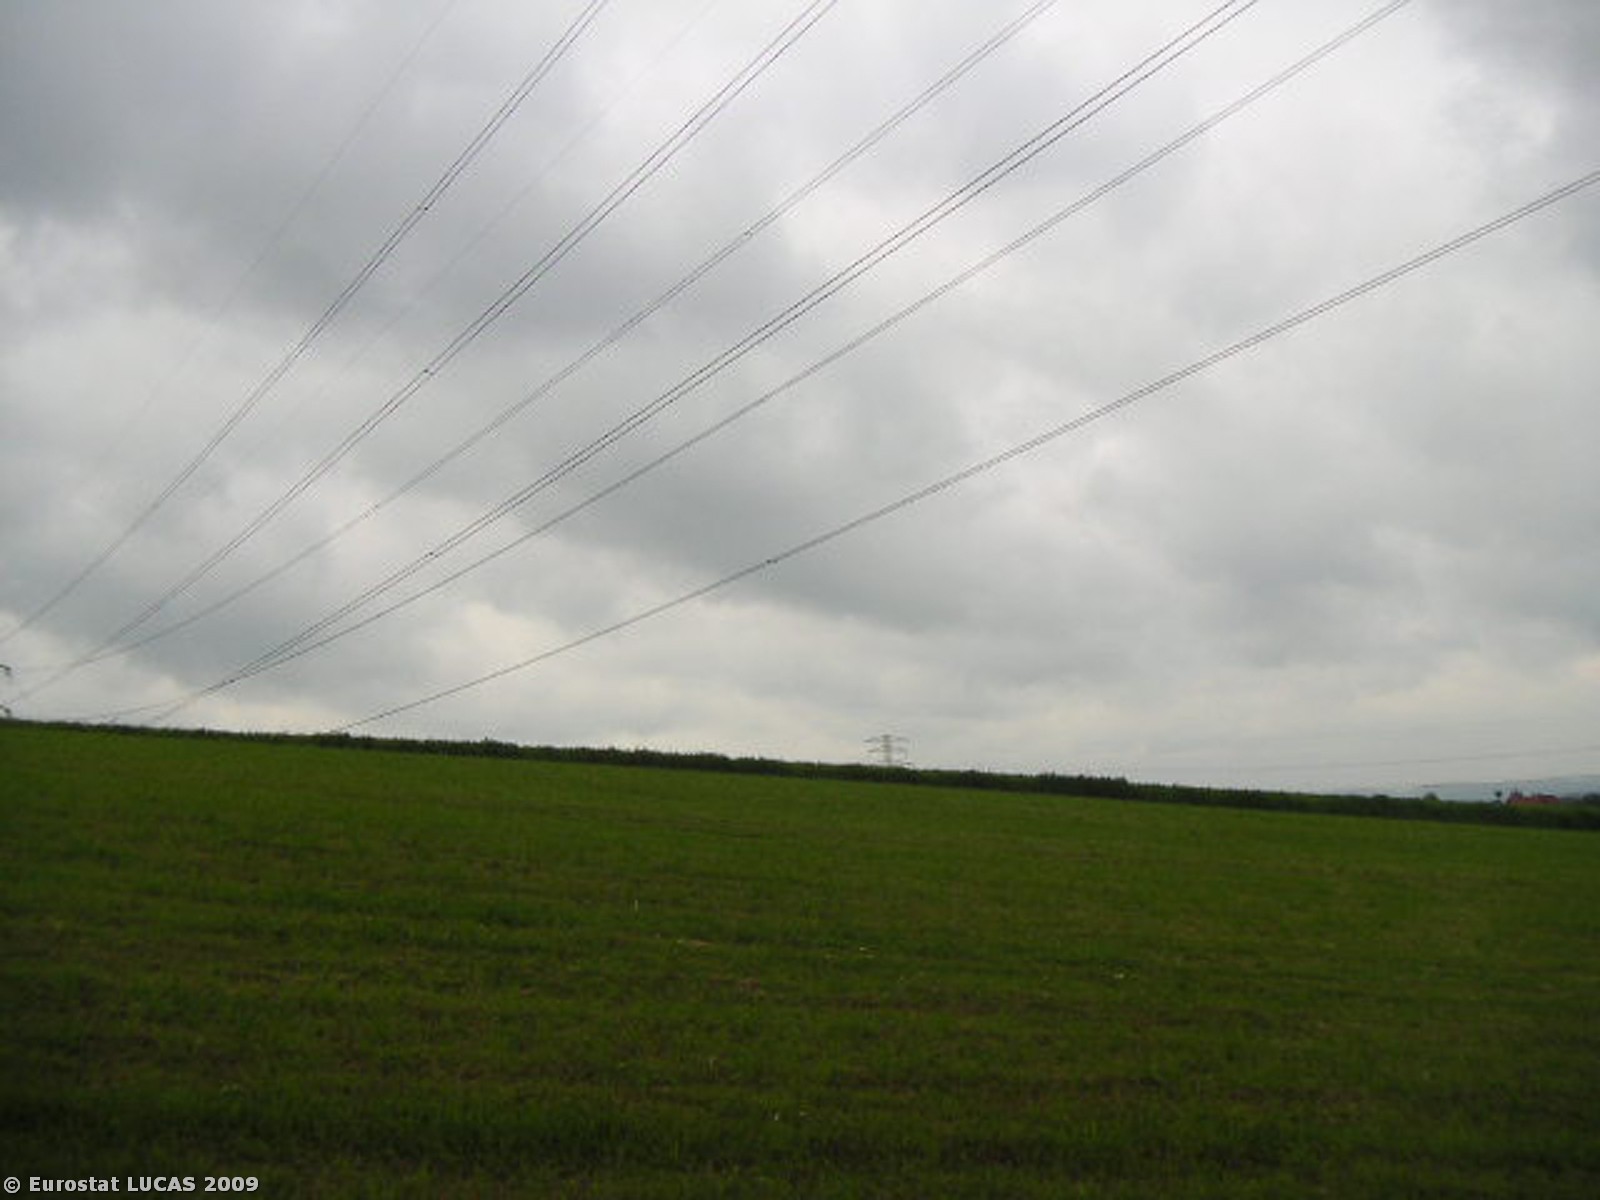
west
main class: Grassland
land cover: Spontaneously vegetated surfaces
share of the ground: > 75 %
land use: Fallow land
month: June
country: PL
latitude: 49.9496
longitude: 19.7151
